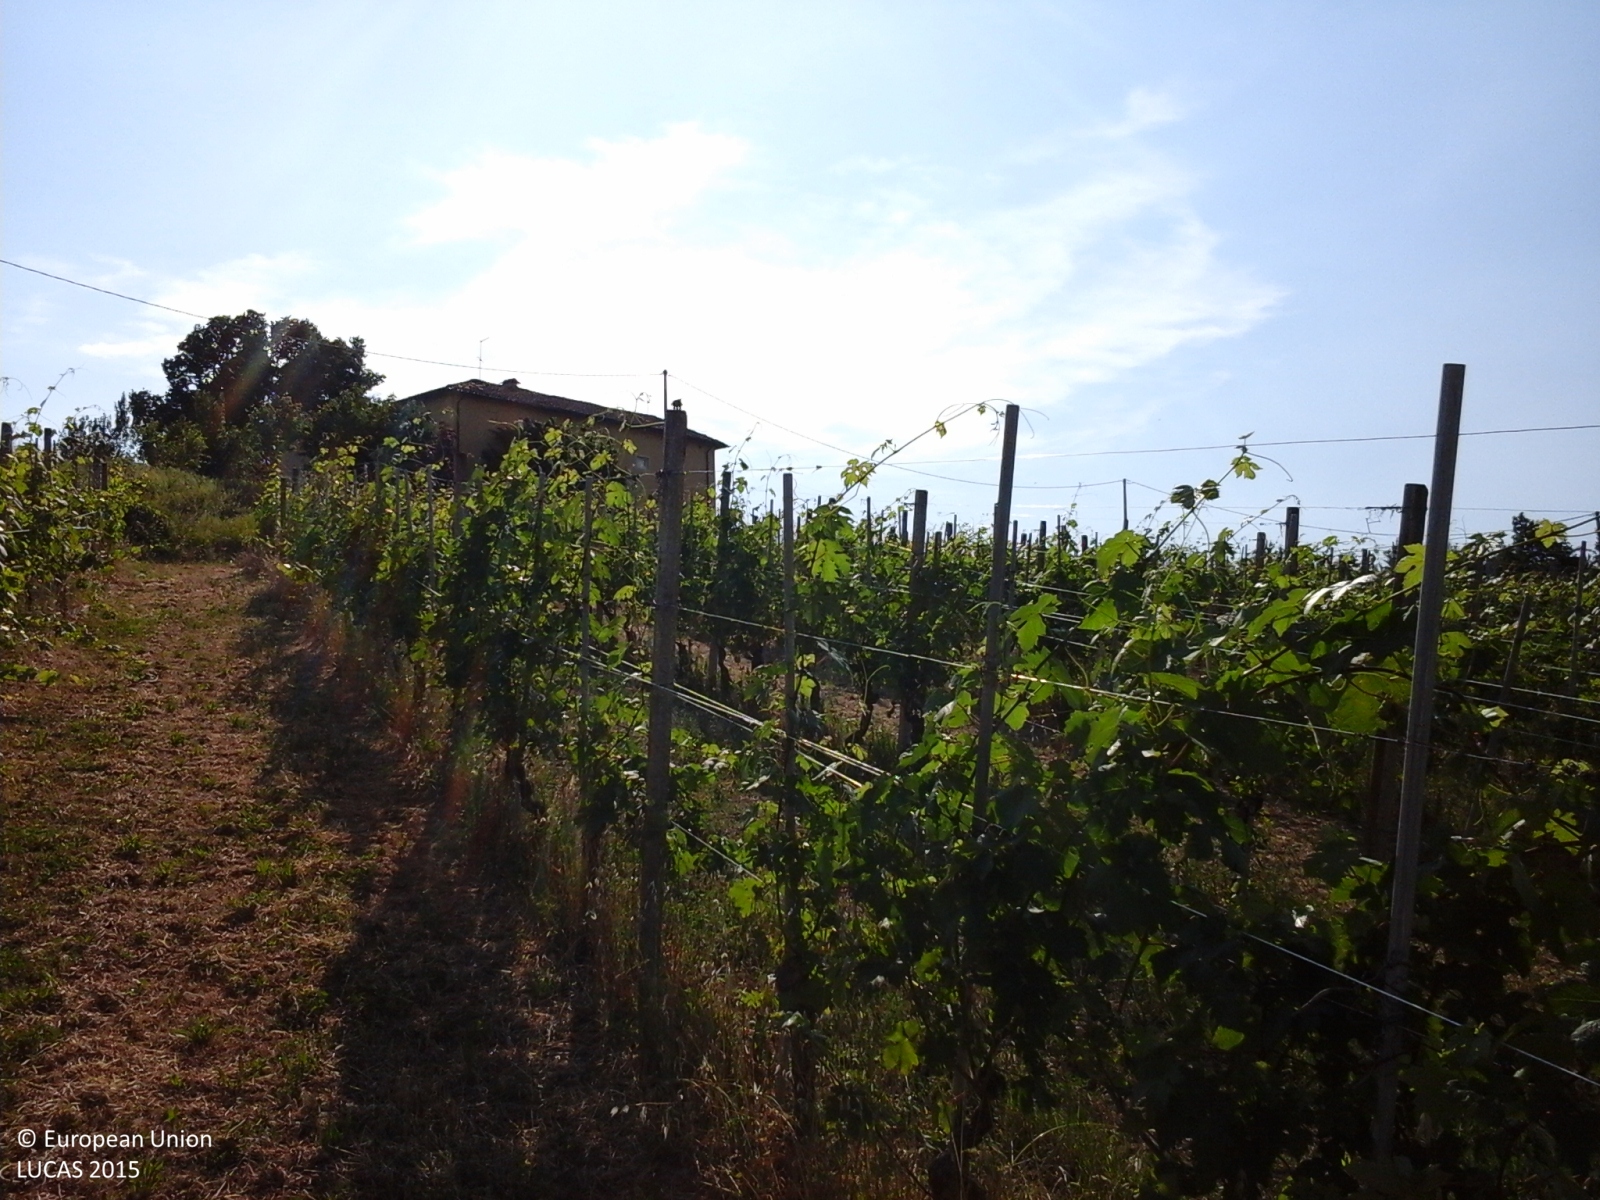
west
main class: Cropland
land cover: Vineyards
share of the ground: 50 - 75 %
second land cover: Grassland without tree/shrub cover
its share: 50 - 75 %
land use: Agriculture (excluding fallow land and kitchen gardens)
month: June
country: IT
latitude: 44.6842
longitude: 8.6276
